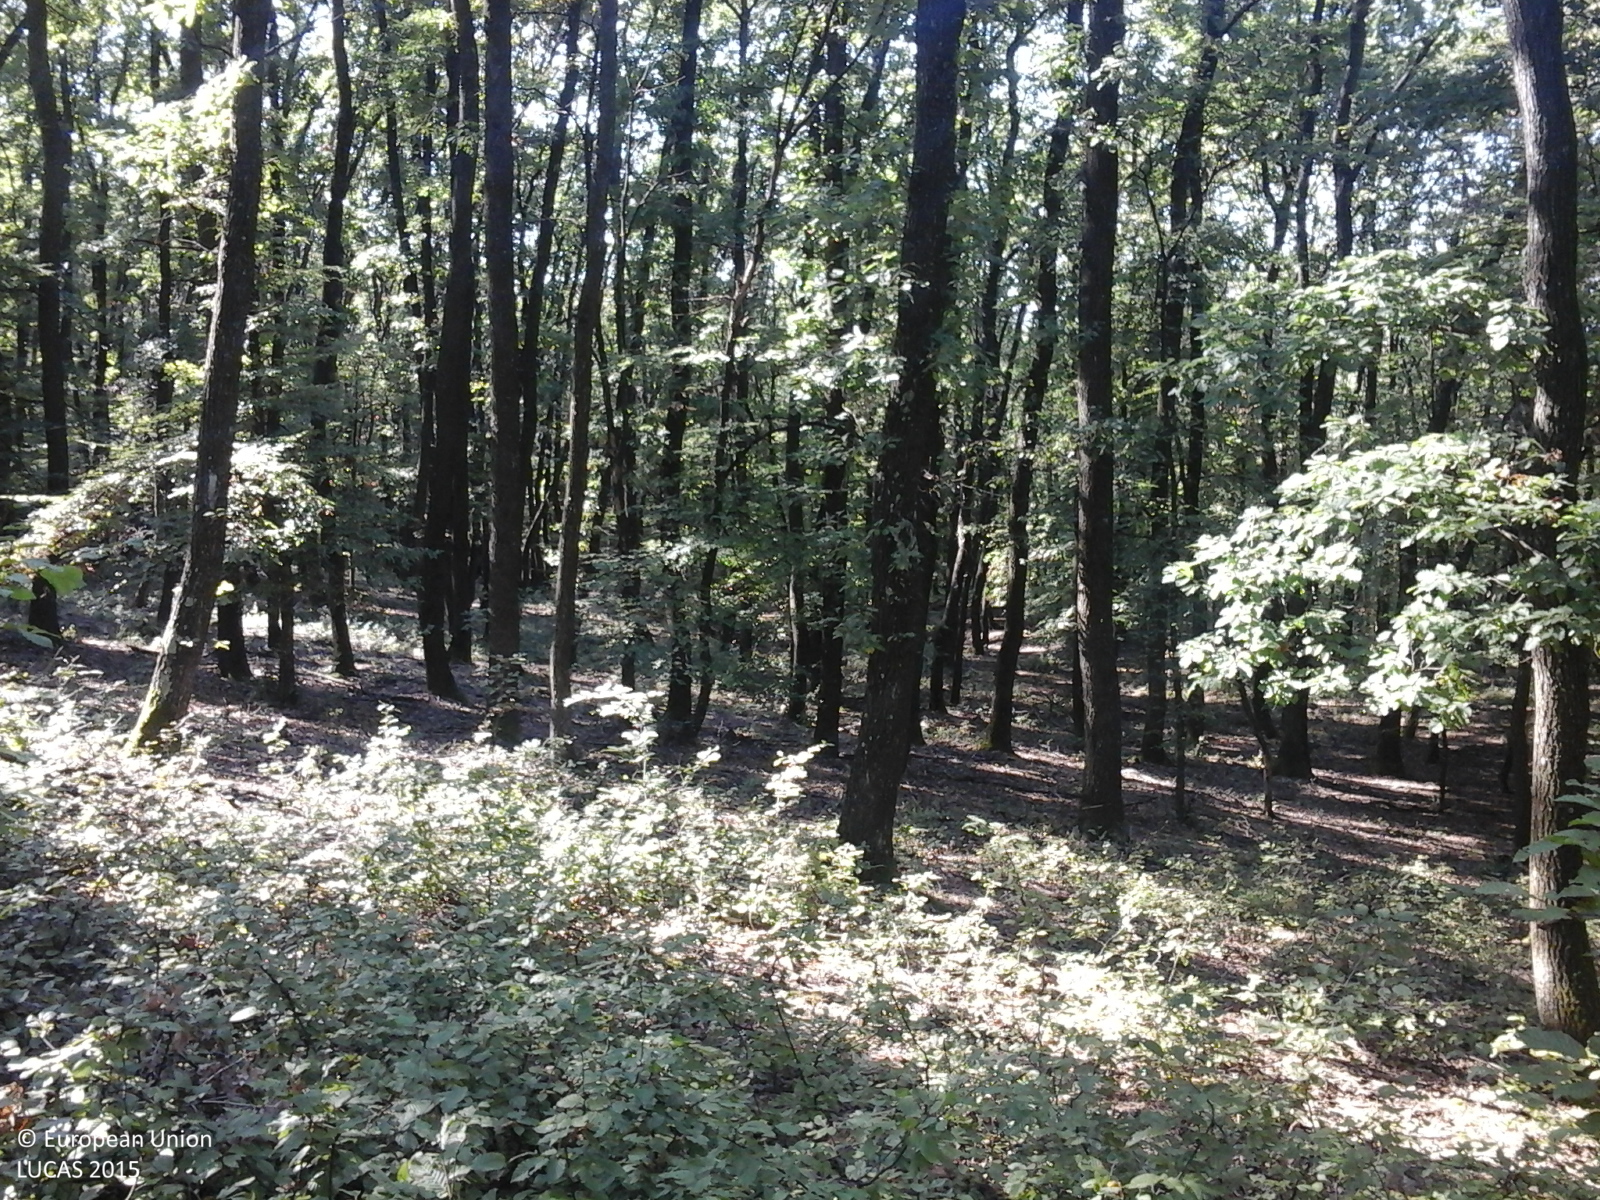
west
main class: Woodland
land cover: Broadleaved woodland
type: acidophilous oak and oak-birch forest
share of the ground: > 75 %
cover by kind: broadleaved forest trees 90 %, herbaceous plants 10 %
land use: Forestry
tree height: > 5 m
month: October
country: RO
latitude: 46.3069
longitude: 23.8227
